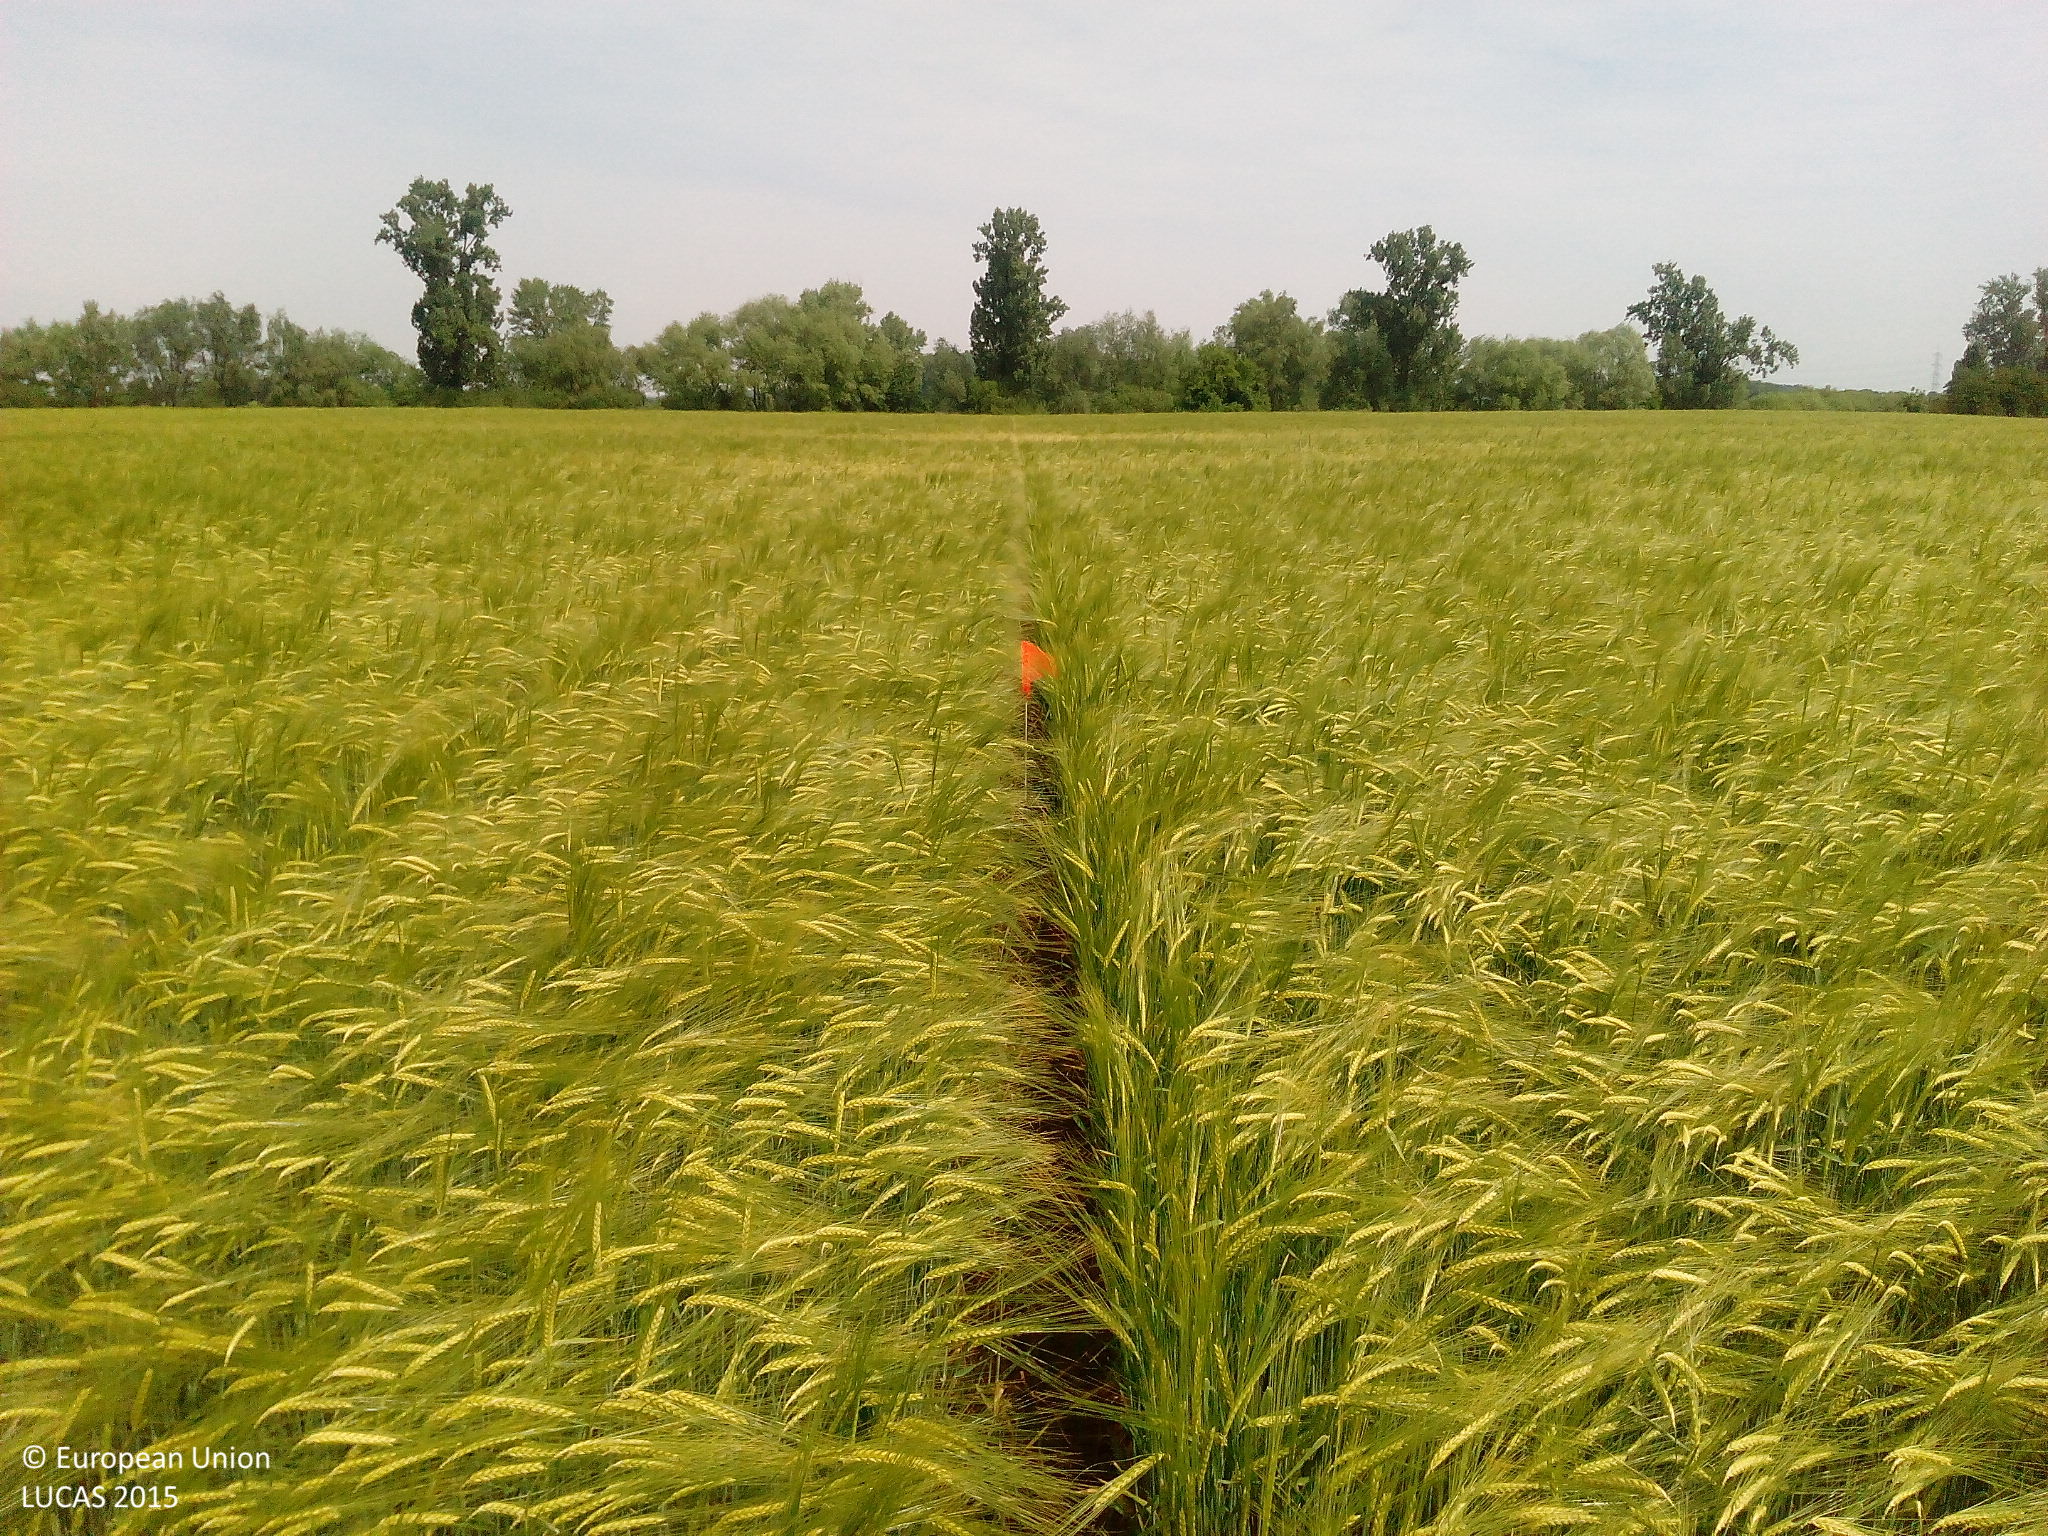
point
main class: Cropland
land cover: Barley
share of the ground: > 75 %
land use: Agriculture (excluding fallow land and kitchen gardens)
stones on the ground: < 10 %
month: May
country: DE
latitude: 49.8328
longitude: 8.5128
